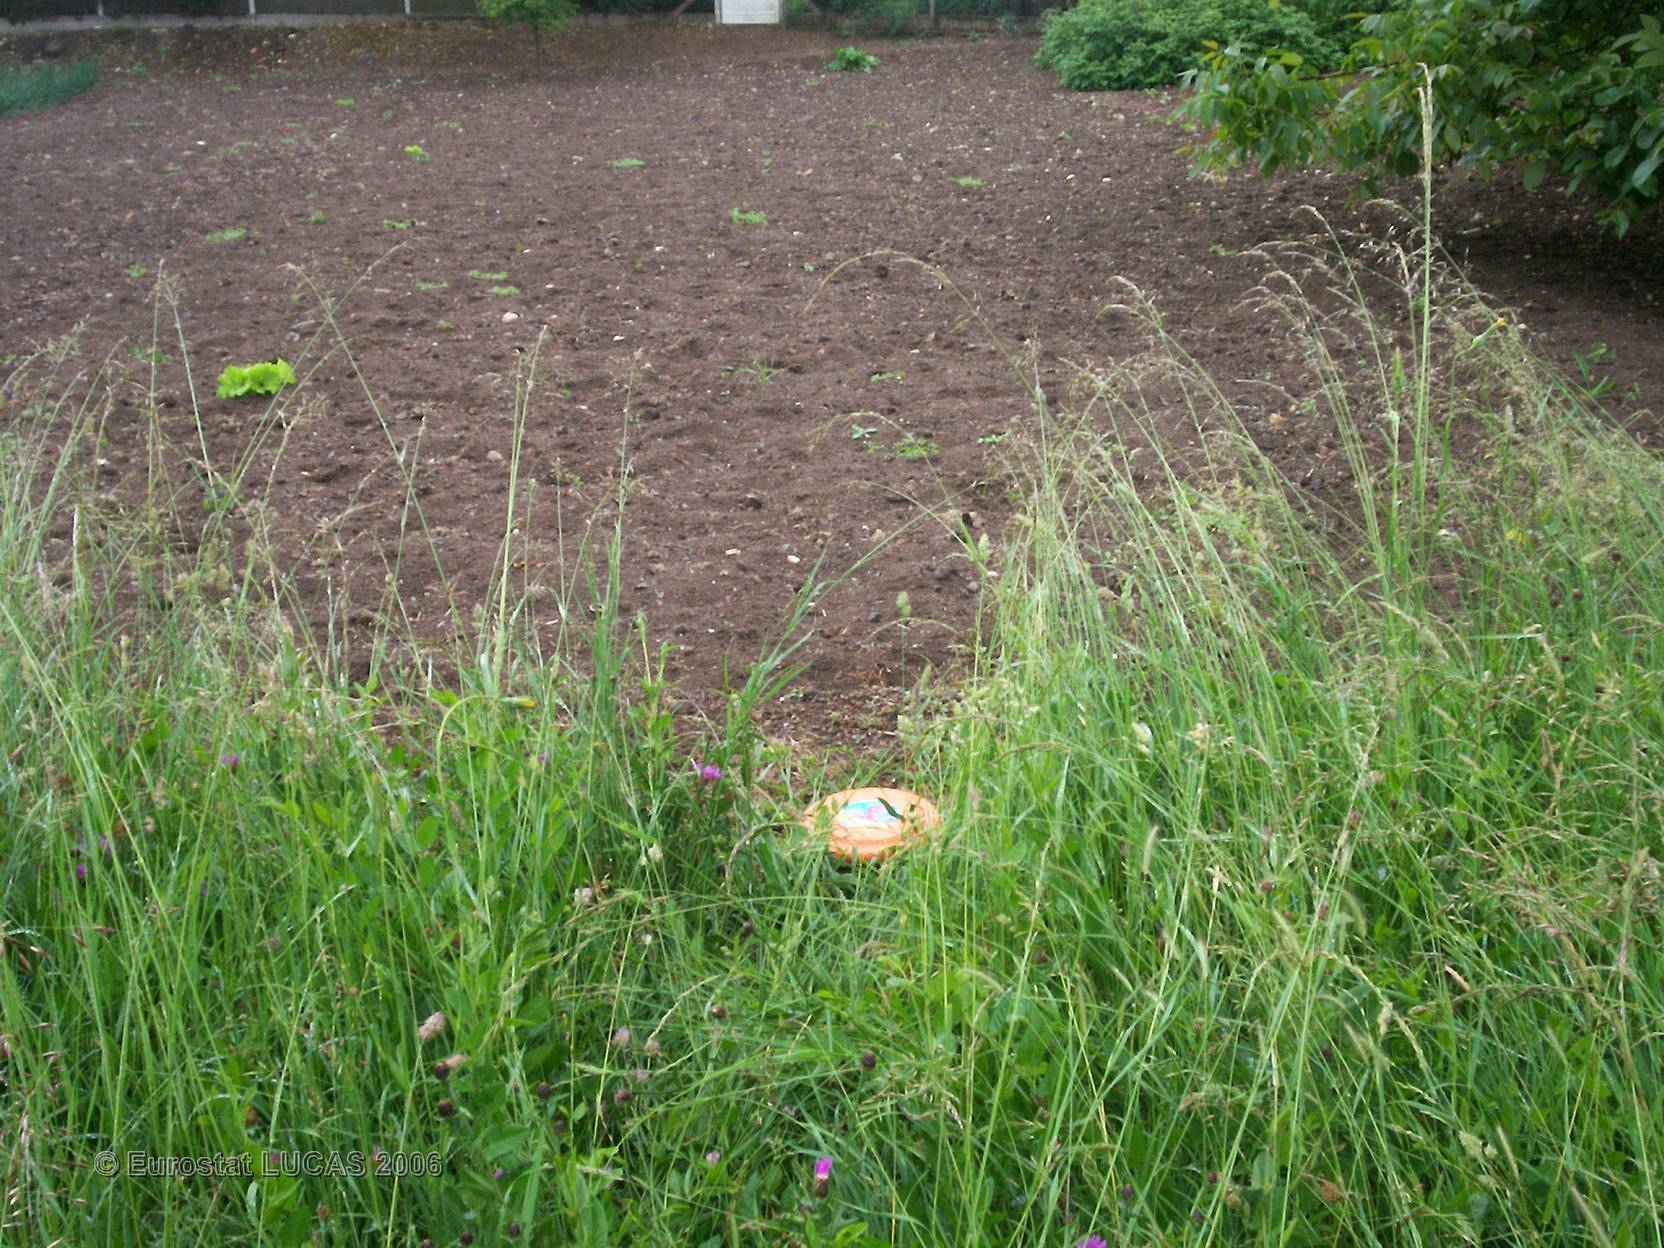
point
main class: Cropland
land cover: Other fresh vegetables
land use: Kitchen garden
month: May
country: FR
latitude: 46.7202
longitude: 0.4436
